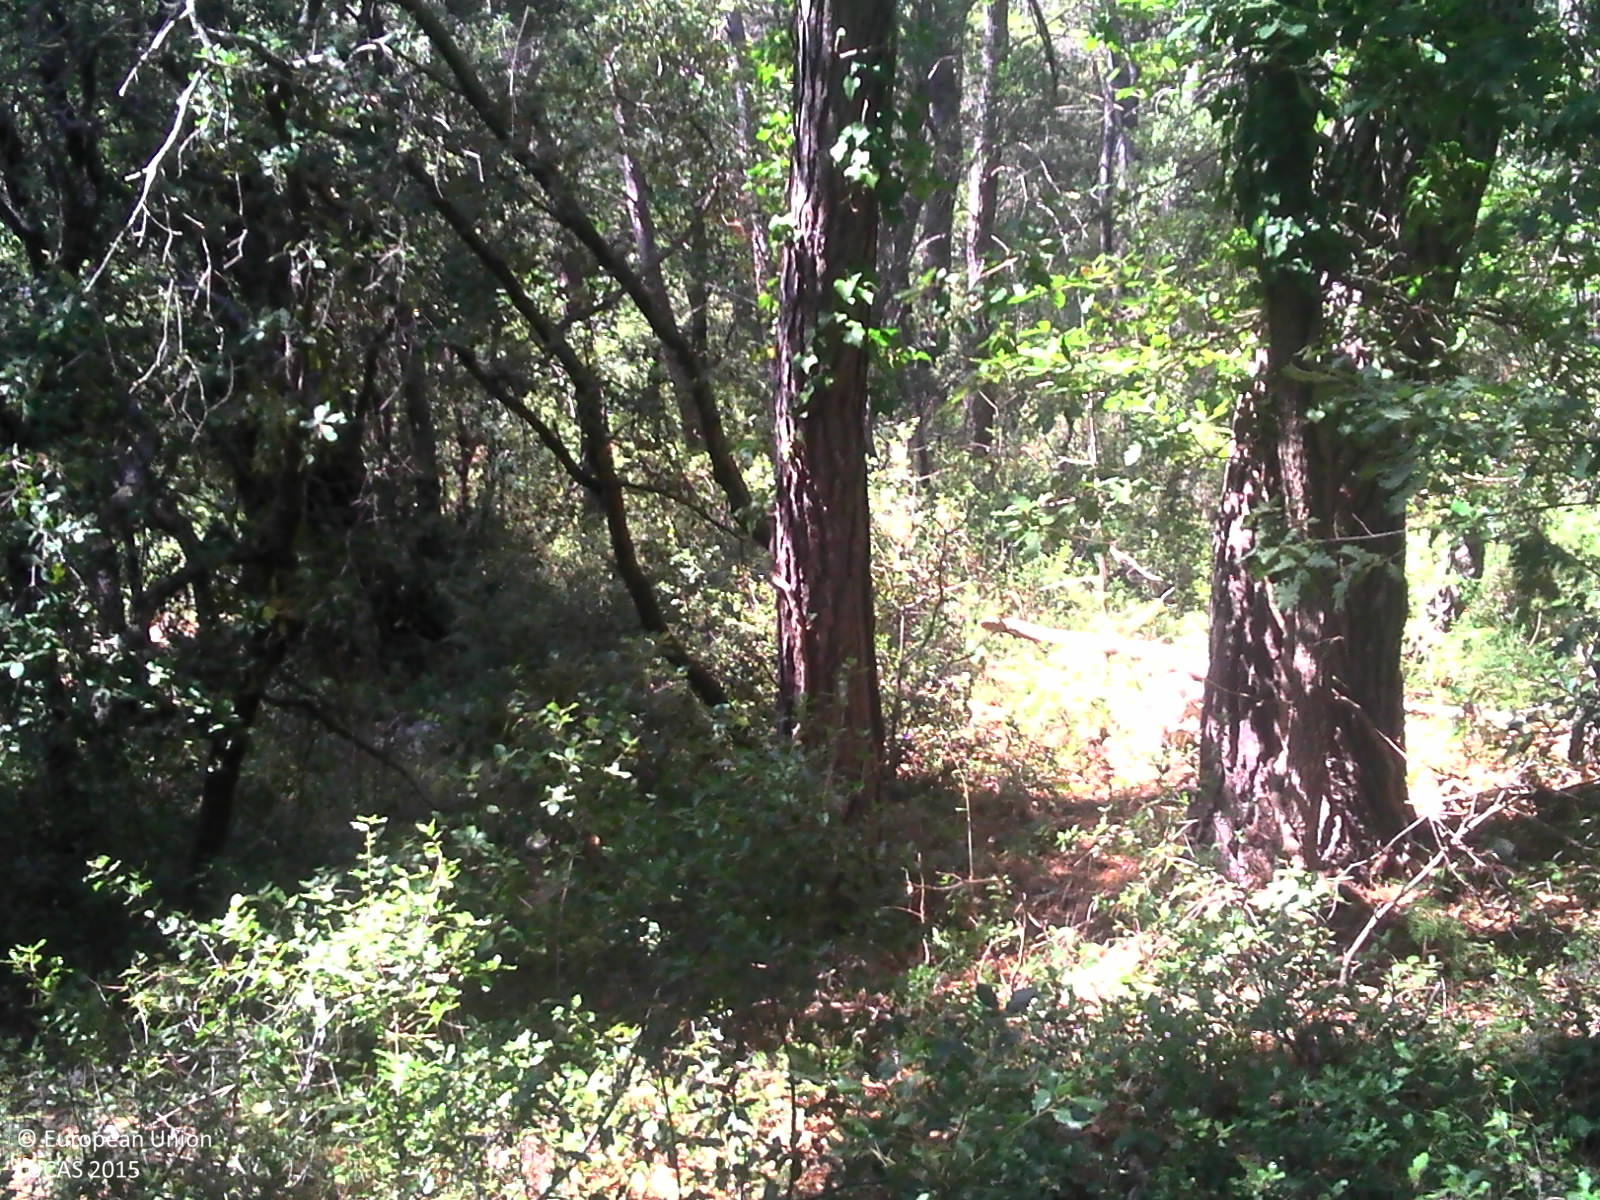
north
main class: Woodland
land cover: Pine dominated mixed woodland
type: coniferous forest of the mediterranean region
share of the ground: > 75 %
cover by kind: coniferous forest trees 45 %, broadleaved forest trees 40 %, herbaceous plants 10 %, shrubs 5 %
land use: Forestry
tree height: > 5 m
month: July
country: FR
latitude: 43.6663
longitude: 5.3091
